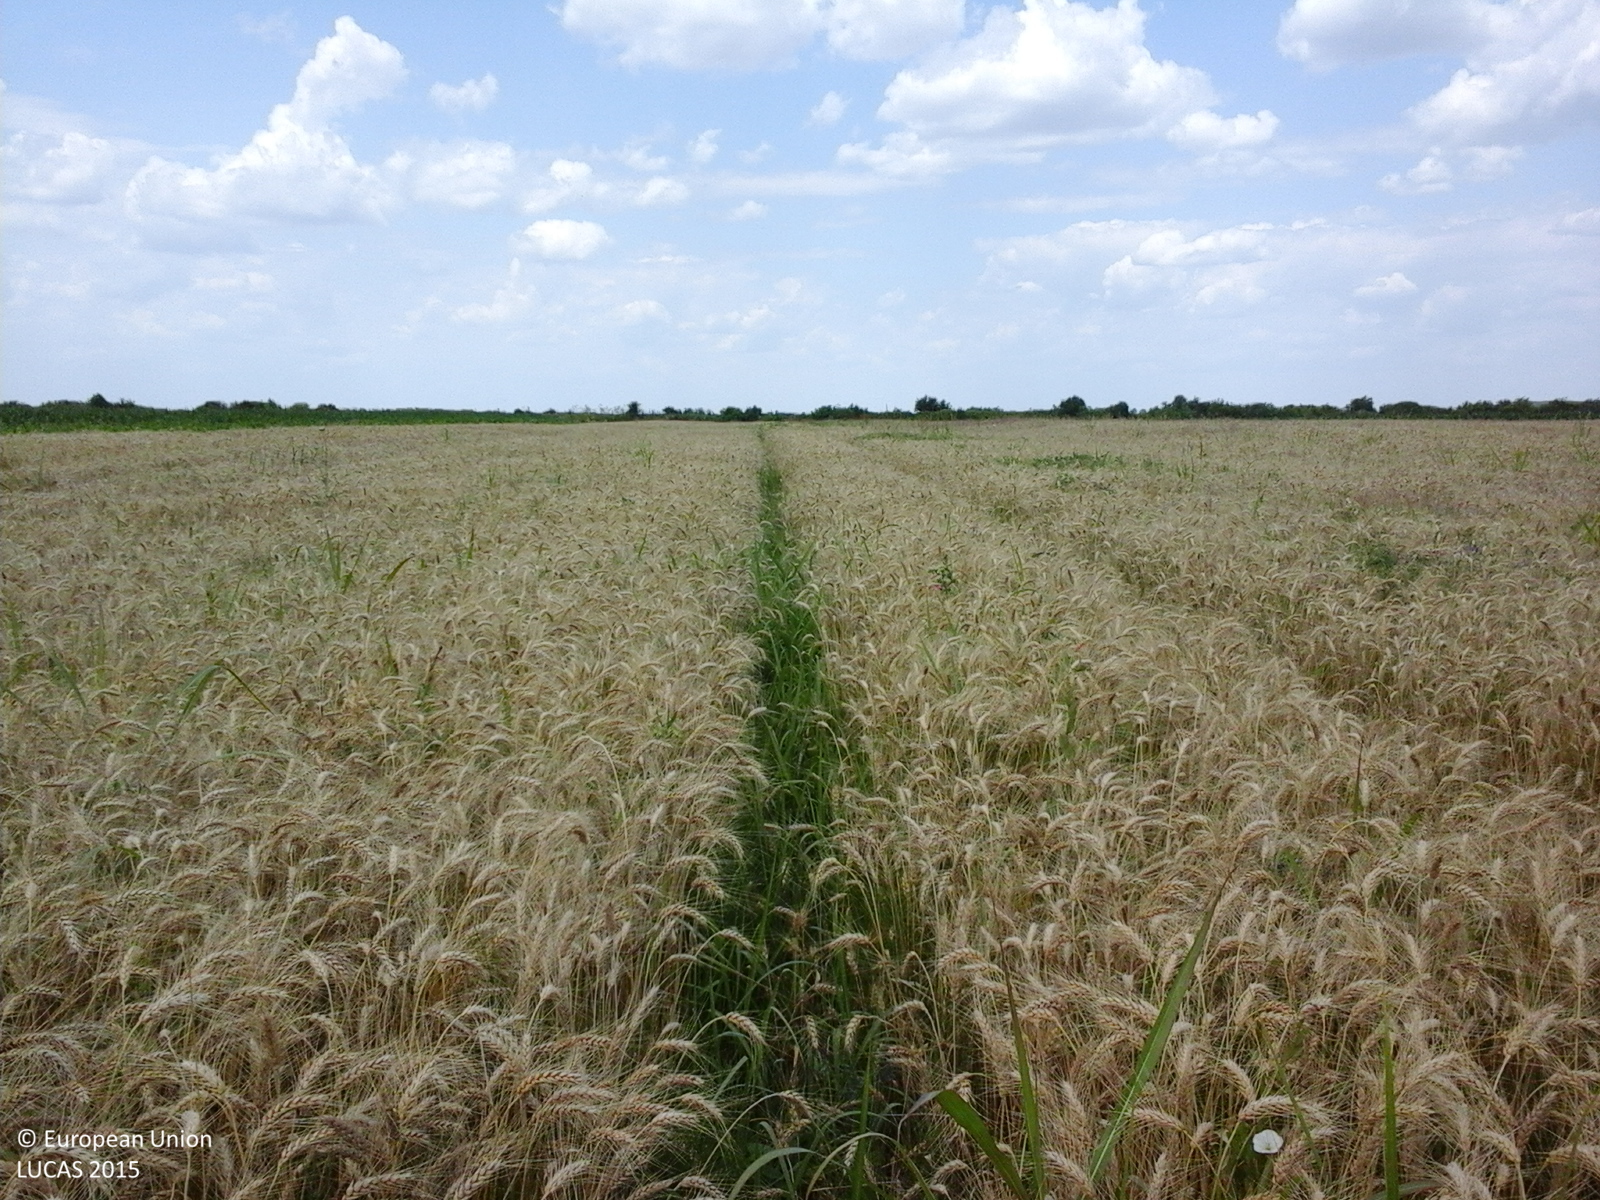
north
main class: Cropland
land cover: Common wheat
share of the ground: > 75 %
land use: Agriculture (excluding fallow land and kitchen gardens)
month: June
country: RO
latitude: 44.1791
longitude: 26.2547
